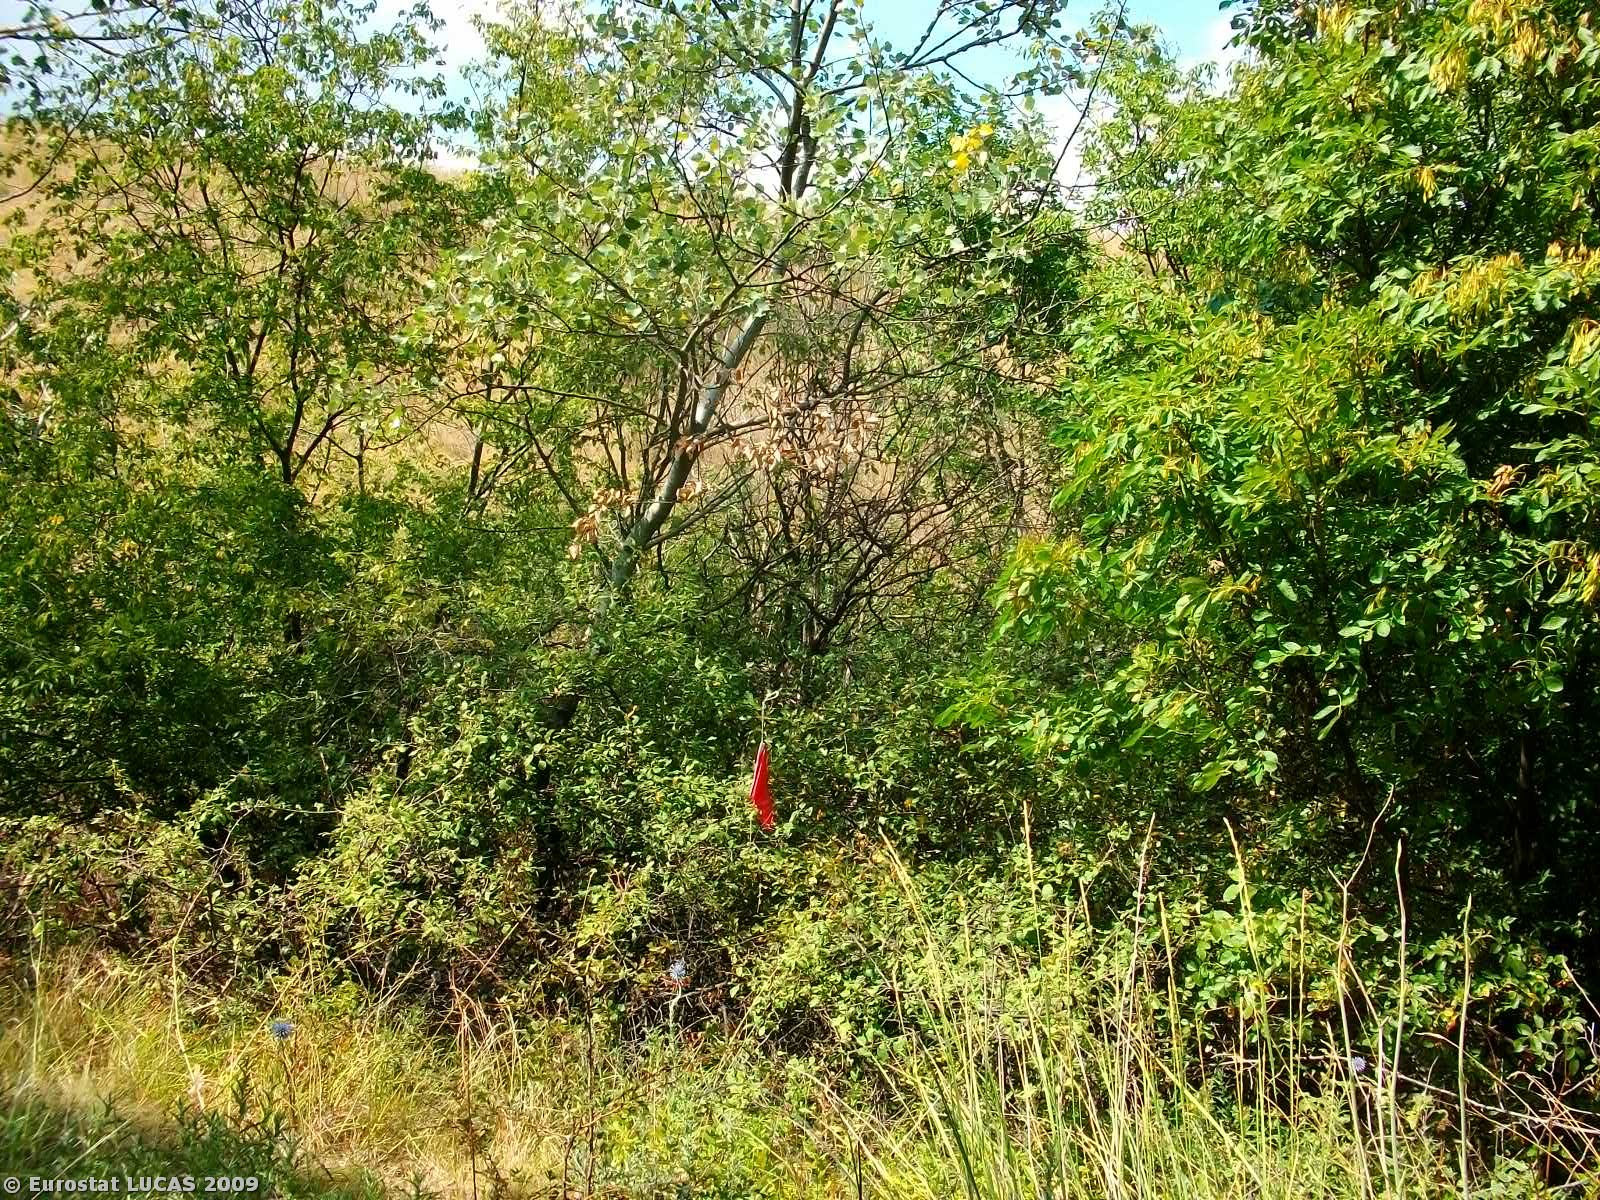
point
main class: Woodland
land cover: Broadleaved woodland
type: thermophilous deciduous forest
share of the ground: 50 - 75 %
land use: Forestry
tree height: > 5 m
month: August
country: GR
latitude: 41.4315
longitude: 26.5330
